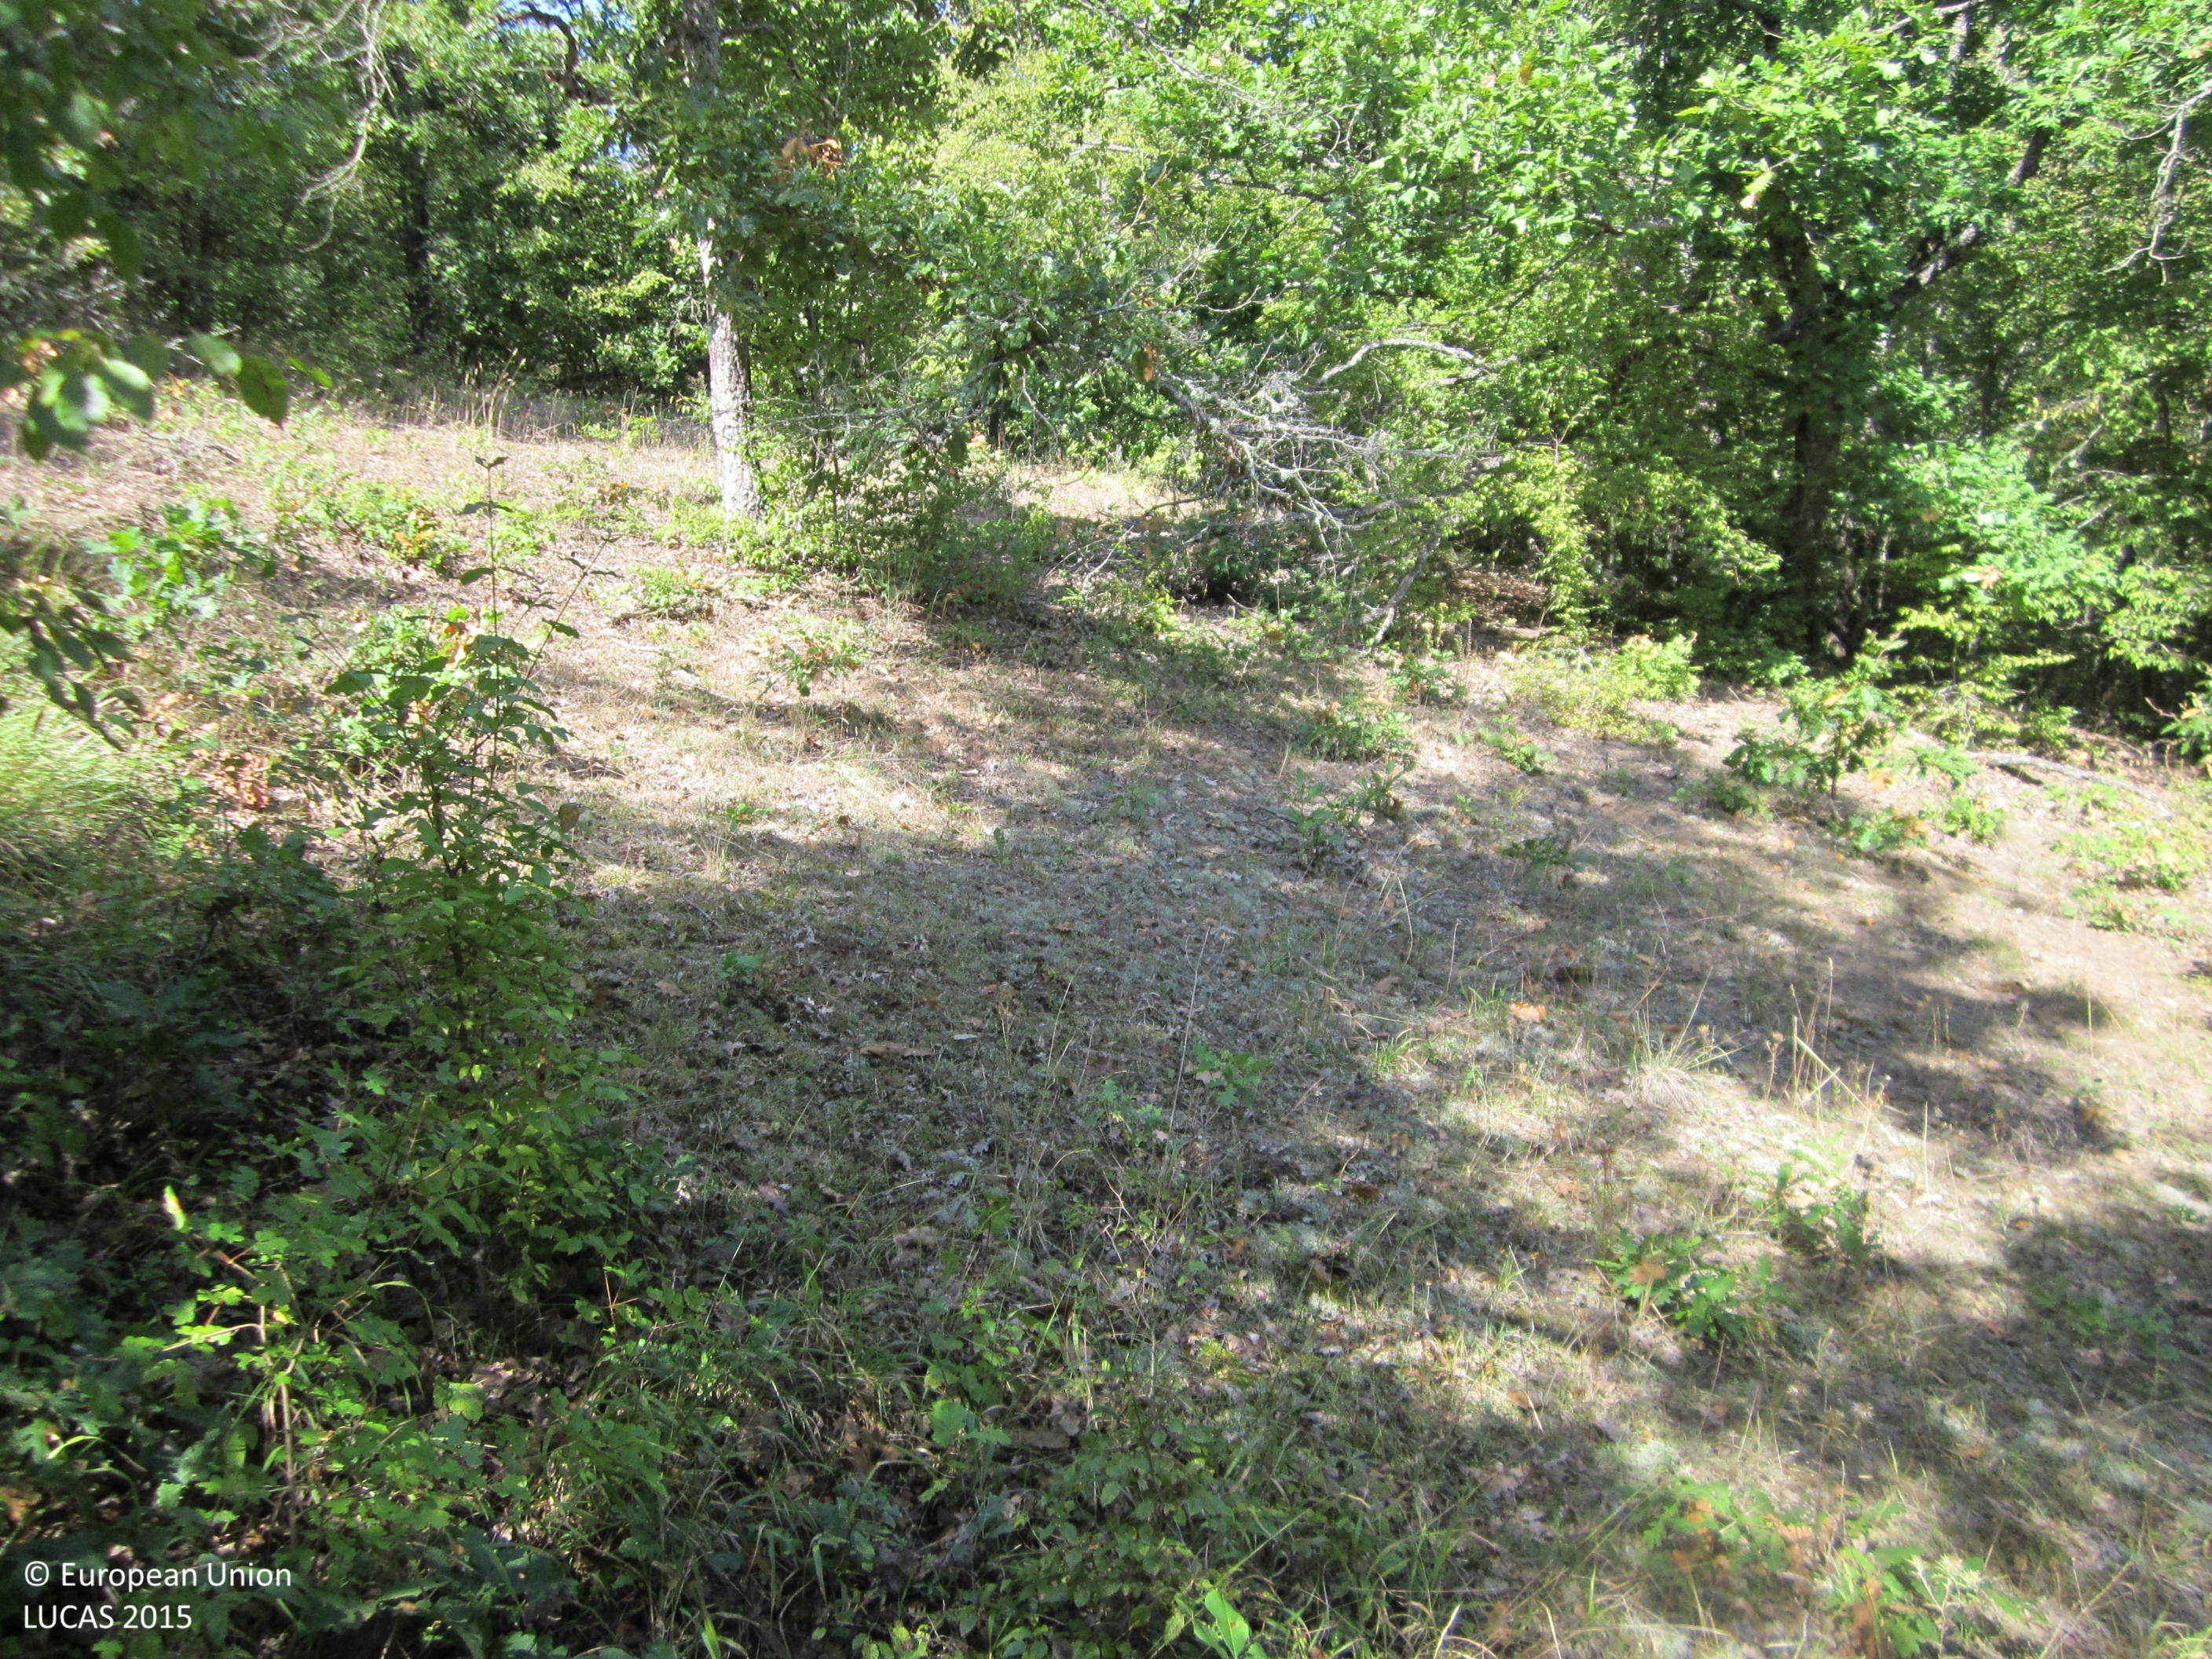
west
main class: Woodland
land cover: Broadleaved woodland
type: thermophilous deciduous forest
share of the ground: > 75 %
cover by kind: broadleaved forest trees 90 %, herbaceous plants 10 %
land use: Forestry
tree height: > 5 m
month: September
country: BG
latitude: 42.2063
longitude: 27.1708
